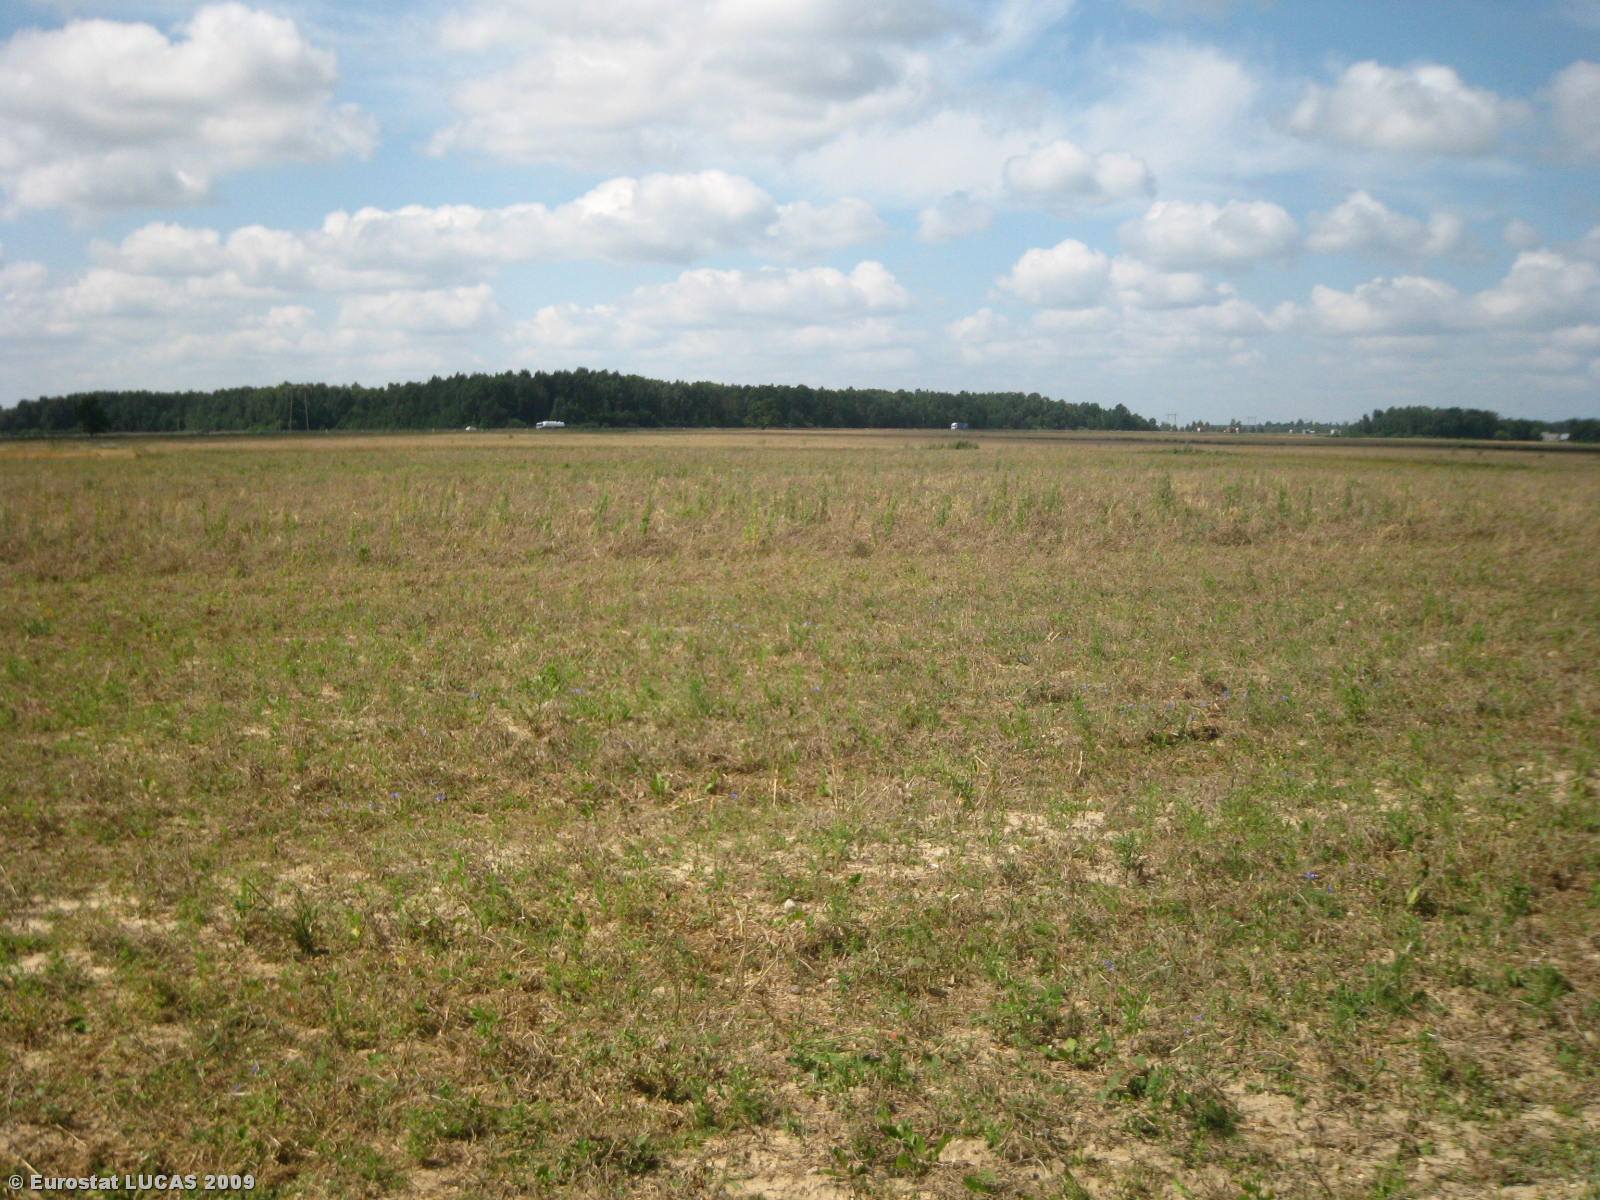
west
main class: Grassland
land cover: Spontaneously vegetated surfaces
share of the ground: > 75 %
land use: Fallow land
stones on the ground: < 10 %
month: August
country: LT
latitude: 55.1780
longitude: 23.6662
